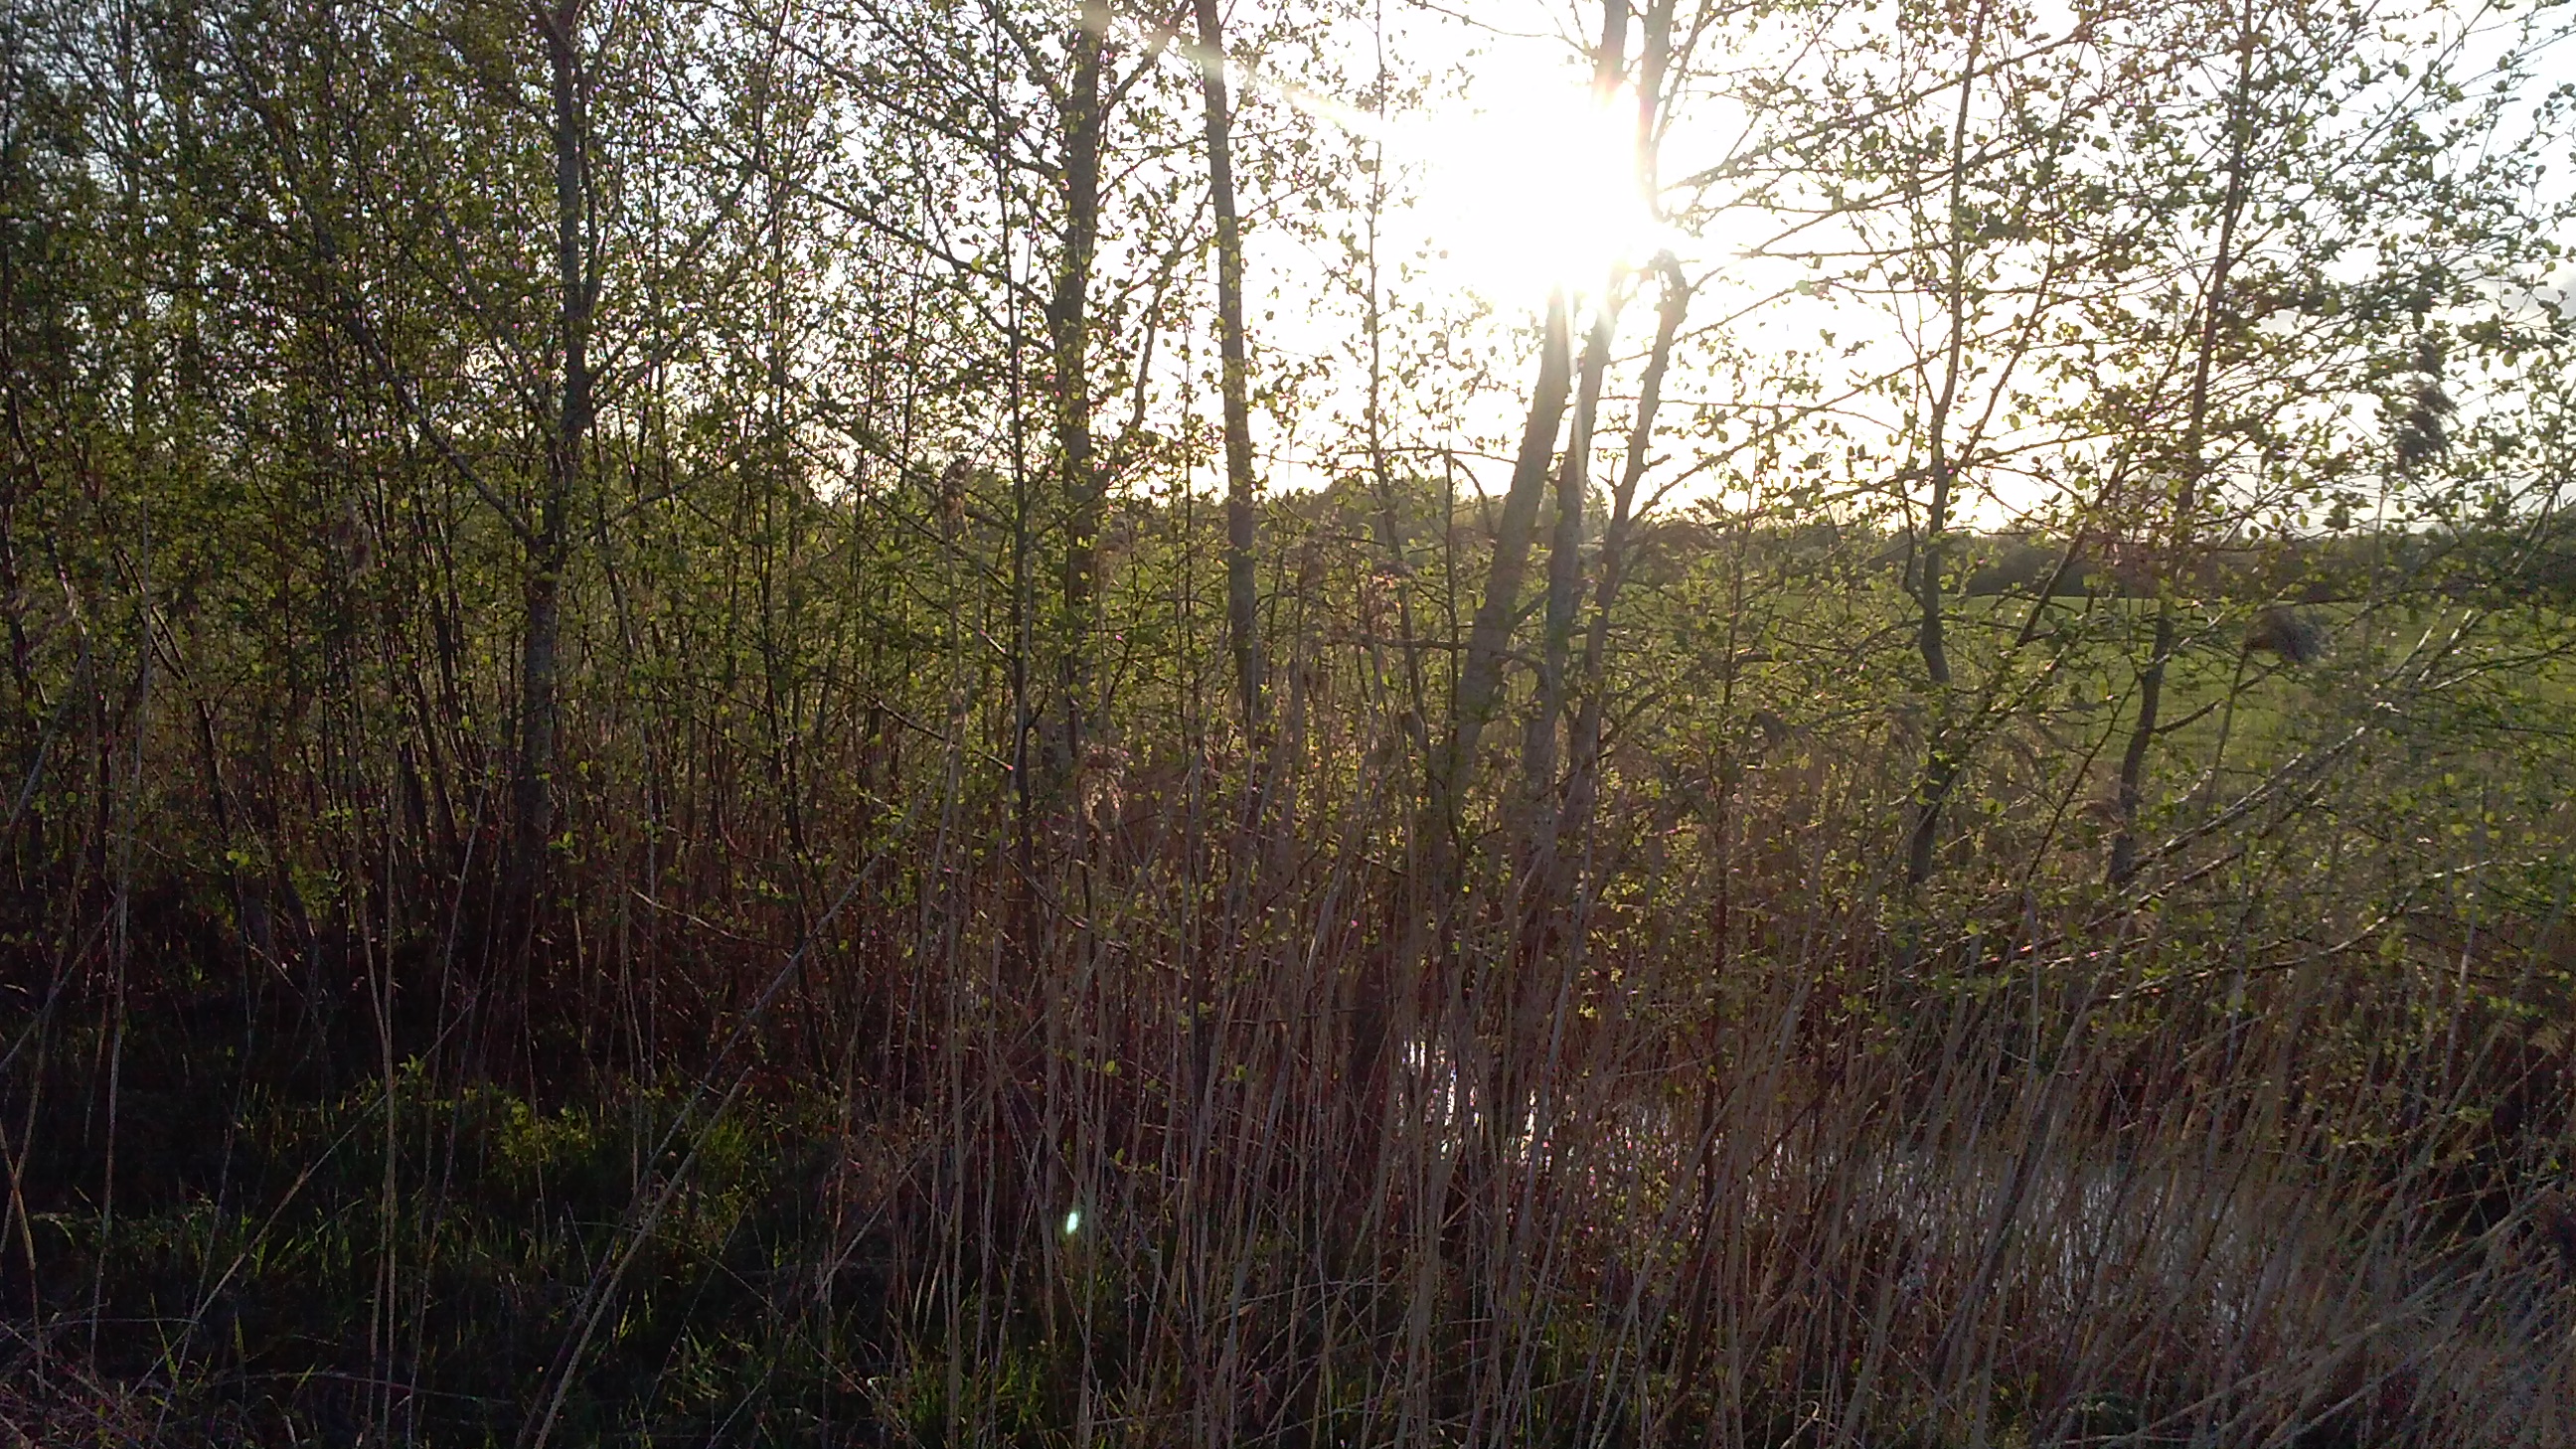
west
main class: Woodland
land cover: Broadleaved woodland
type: non-riverine alder, birch or aspen forest
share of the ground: > 75 %
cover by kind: broadleaved forest trees 100 %
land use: Forestry
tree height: > 5 m
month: May
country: LV
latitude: 56.1011
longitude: 27.1965
